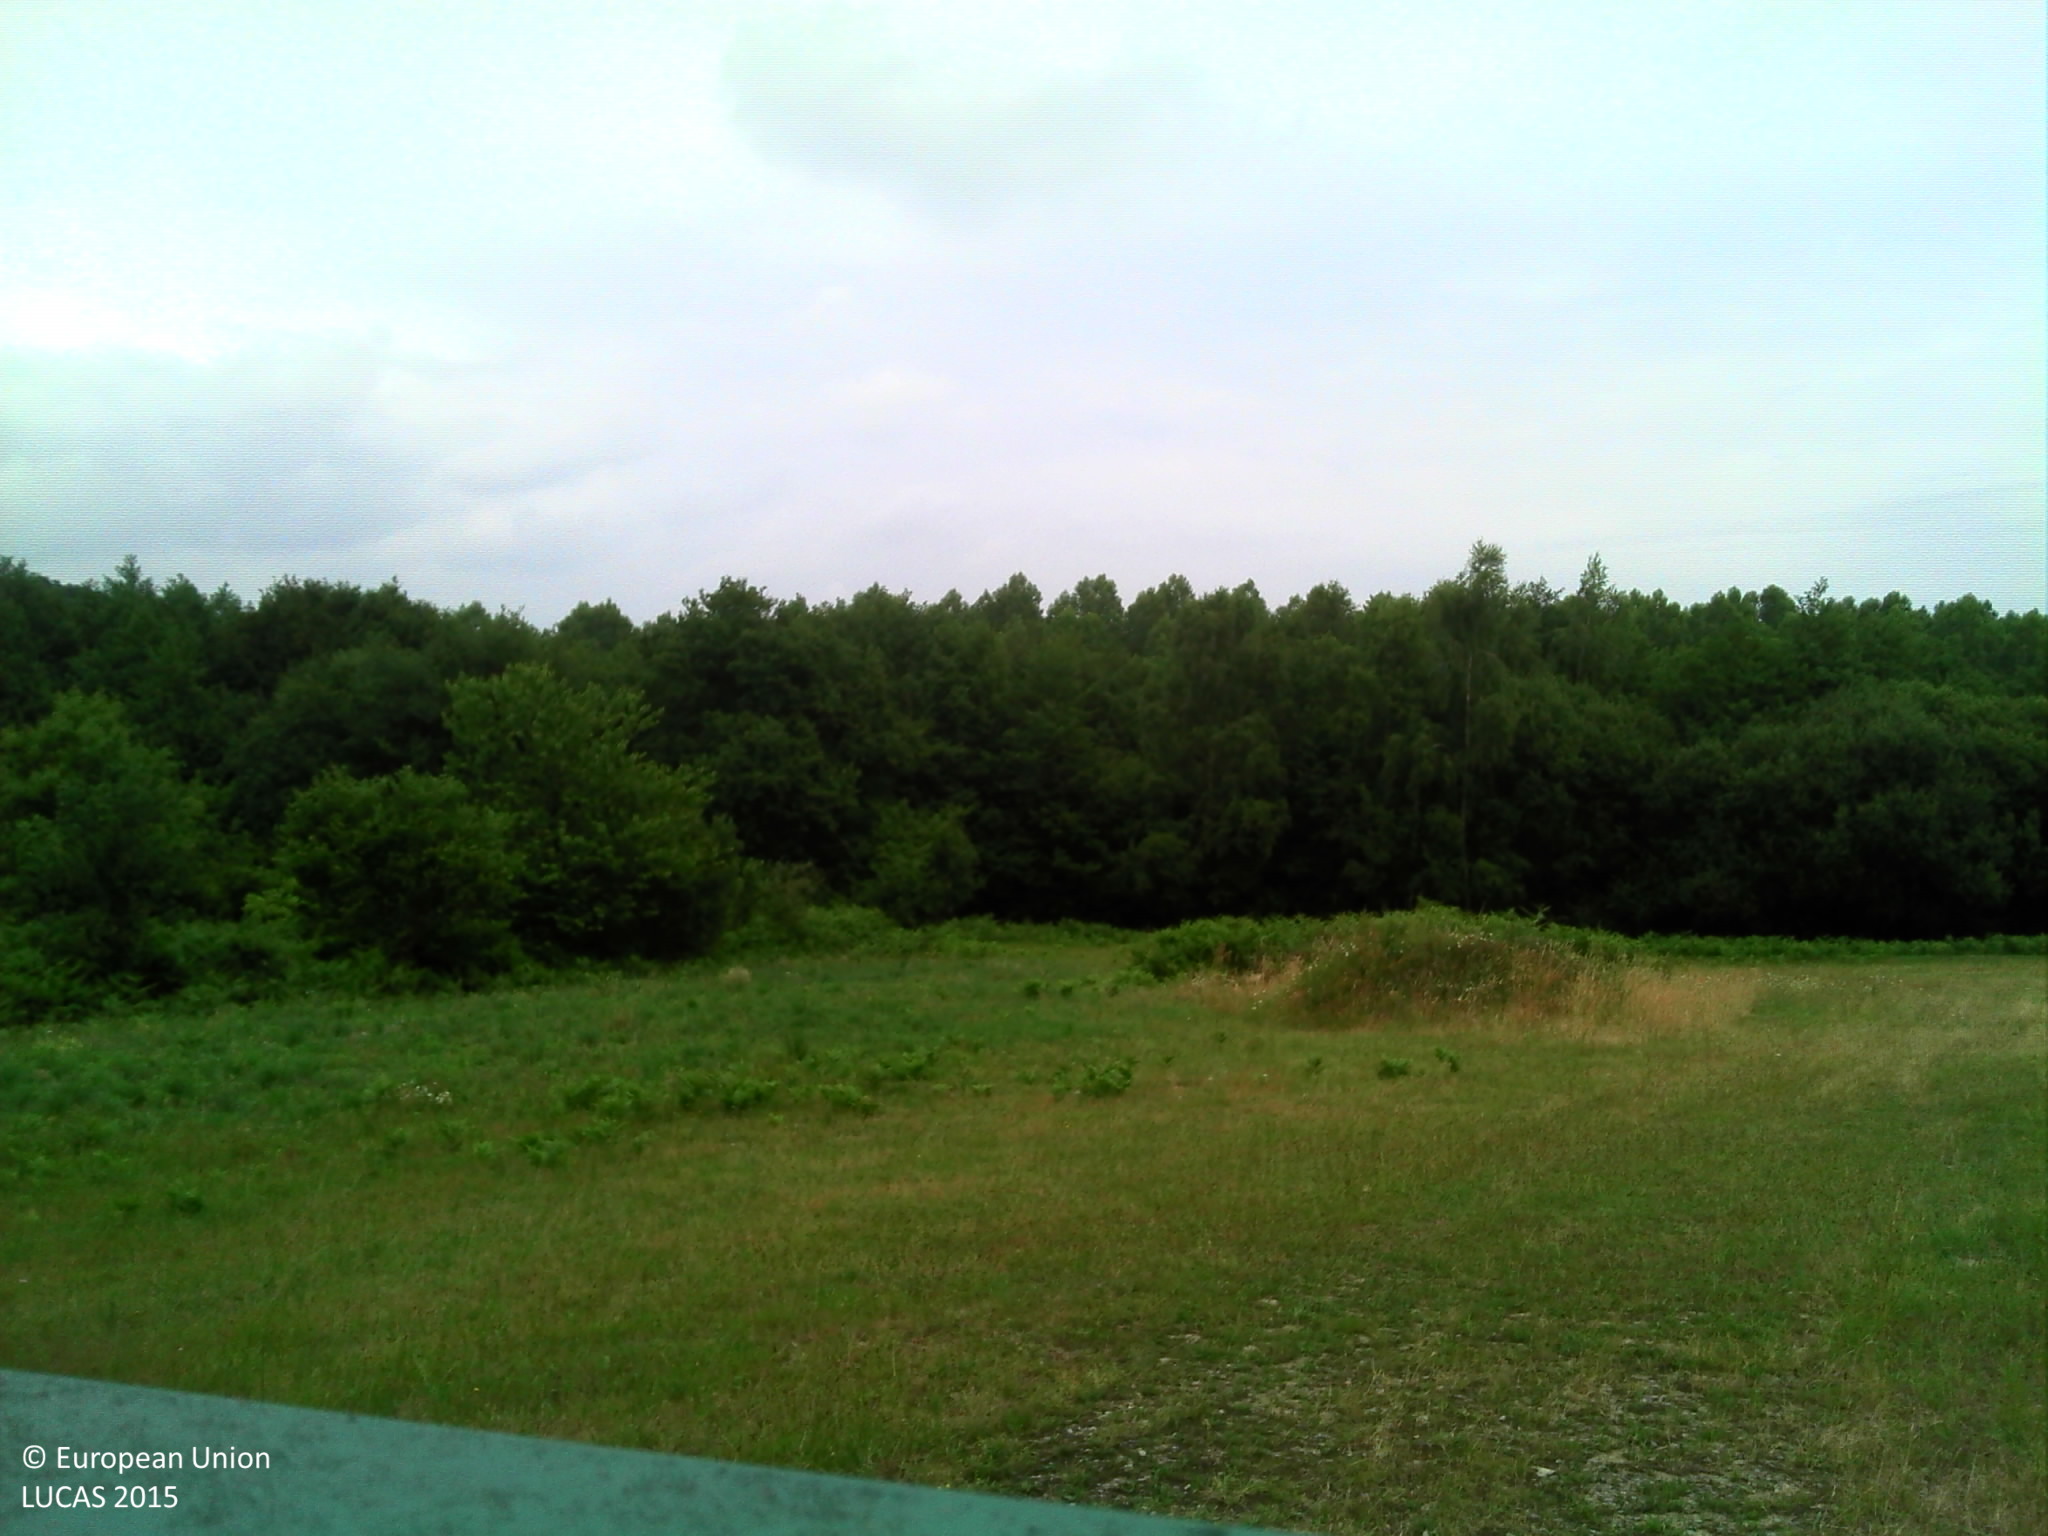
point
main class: Grassland
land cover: Grassland without tree/shrub cover
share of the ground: > 75 %
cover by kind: herbaceous plants 100 %
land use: Agriculture (excluding fallow land and kitchen gardens)
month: June
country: FR
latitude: 47.4606
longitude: 0.0120
